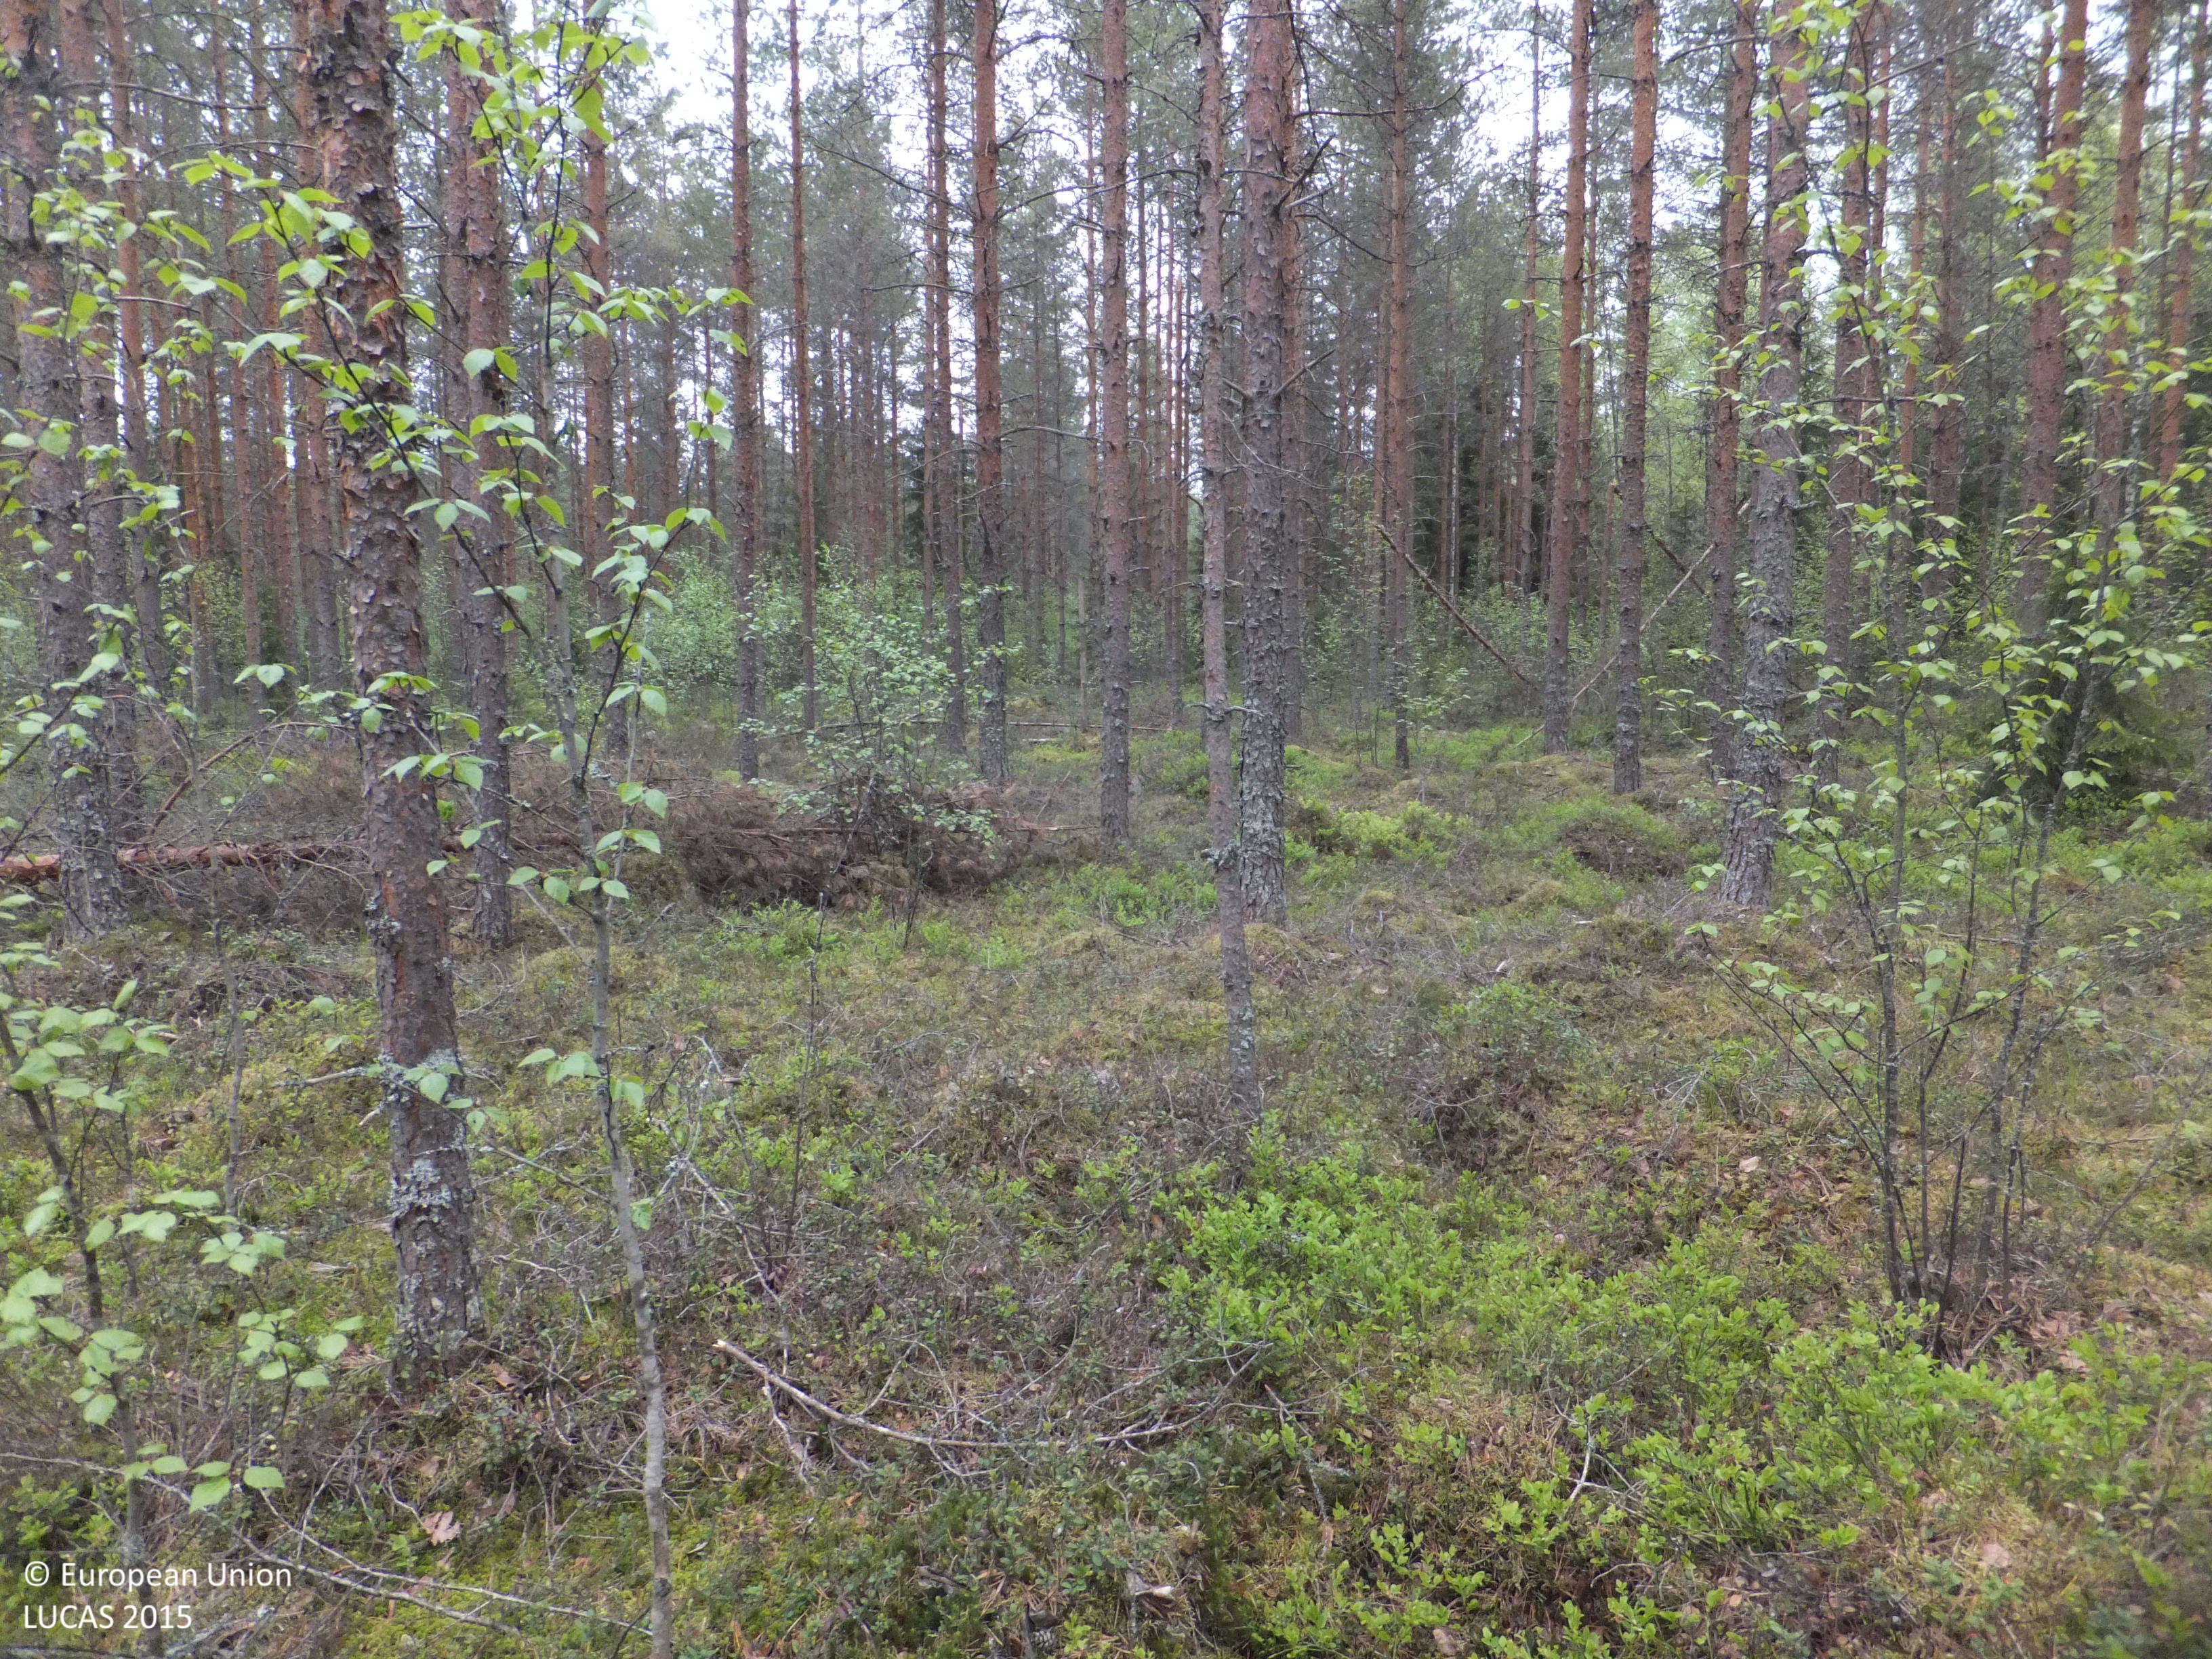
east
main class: Woodland
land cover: Pine dominated coniferous woodland
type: hemiboreal forest and nemoral coniferous forest and mixed broadleaved-coniferous forest
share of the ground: > 75 %
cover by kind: coniferous forest trees 80 %, shrubs 15 %, lichens and mosses 5 %
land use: Forestry
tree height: > 5 m
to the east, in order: Pine dominated coniferous woodland; Ditches and canals; Pine dominated coniferous woodland; Ditches and canals; Pine dominated coniferous woodland
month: June
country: FI
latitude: 63.4920
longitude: 22.8037
